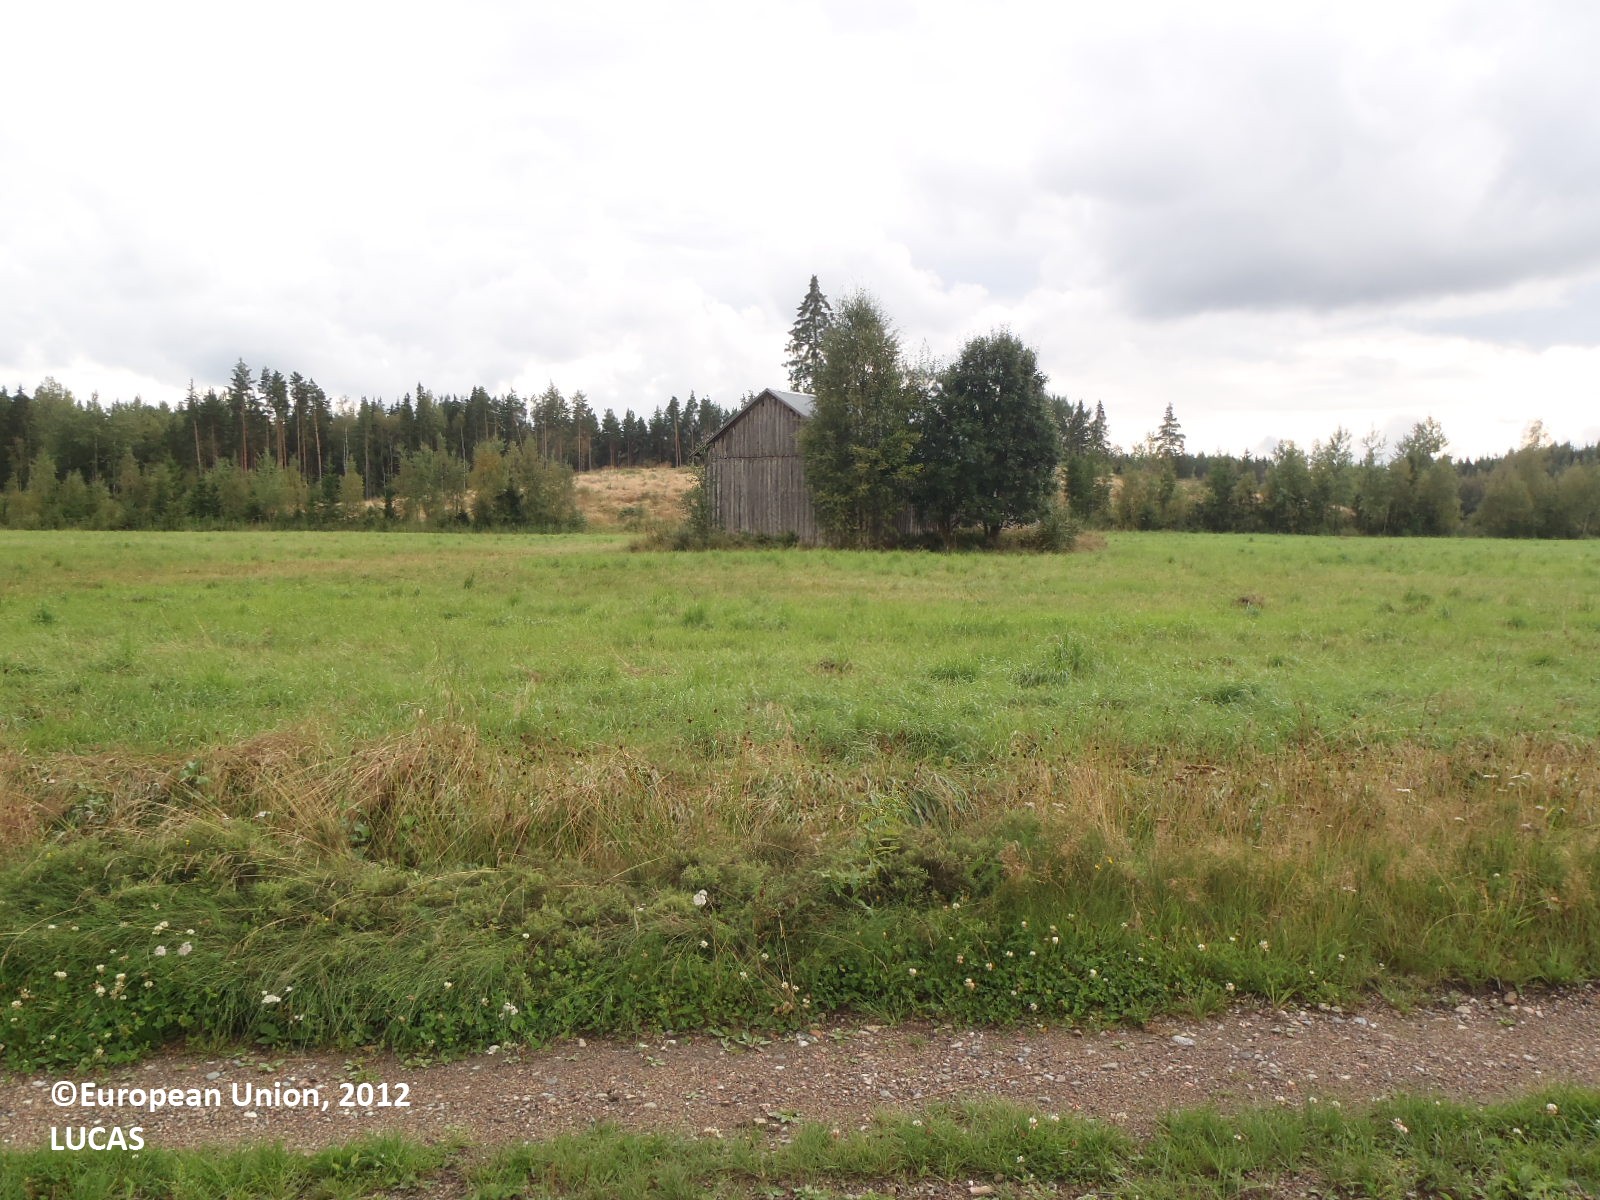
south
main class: Cropland
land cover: Barley
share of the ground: > 75 %
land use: Agriculture (excluding fallow land and kitchen gardens)
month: August
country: FI
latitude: 60.6178
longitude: 22.1791
